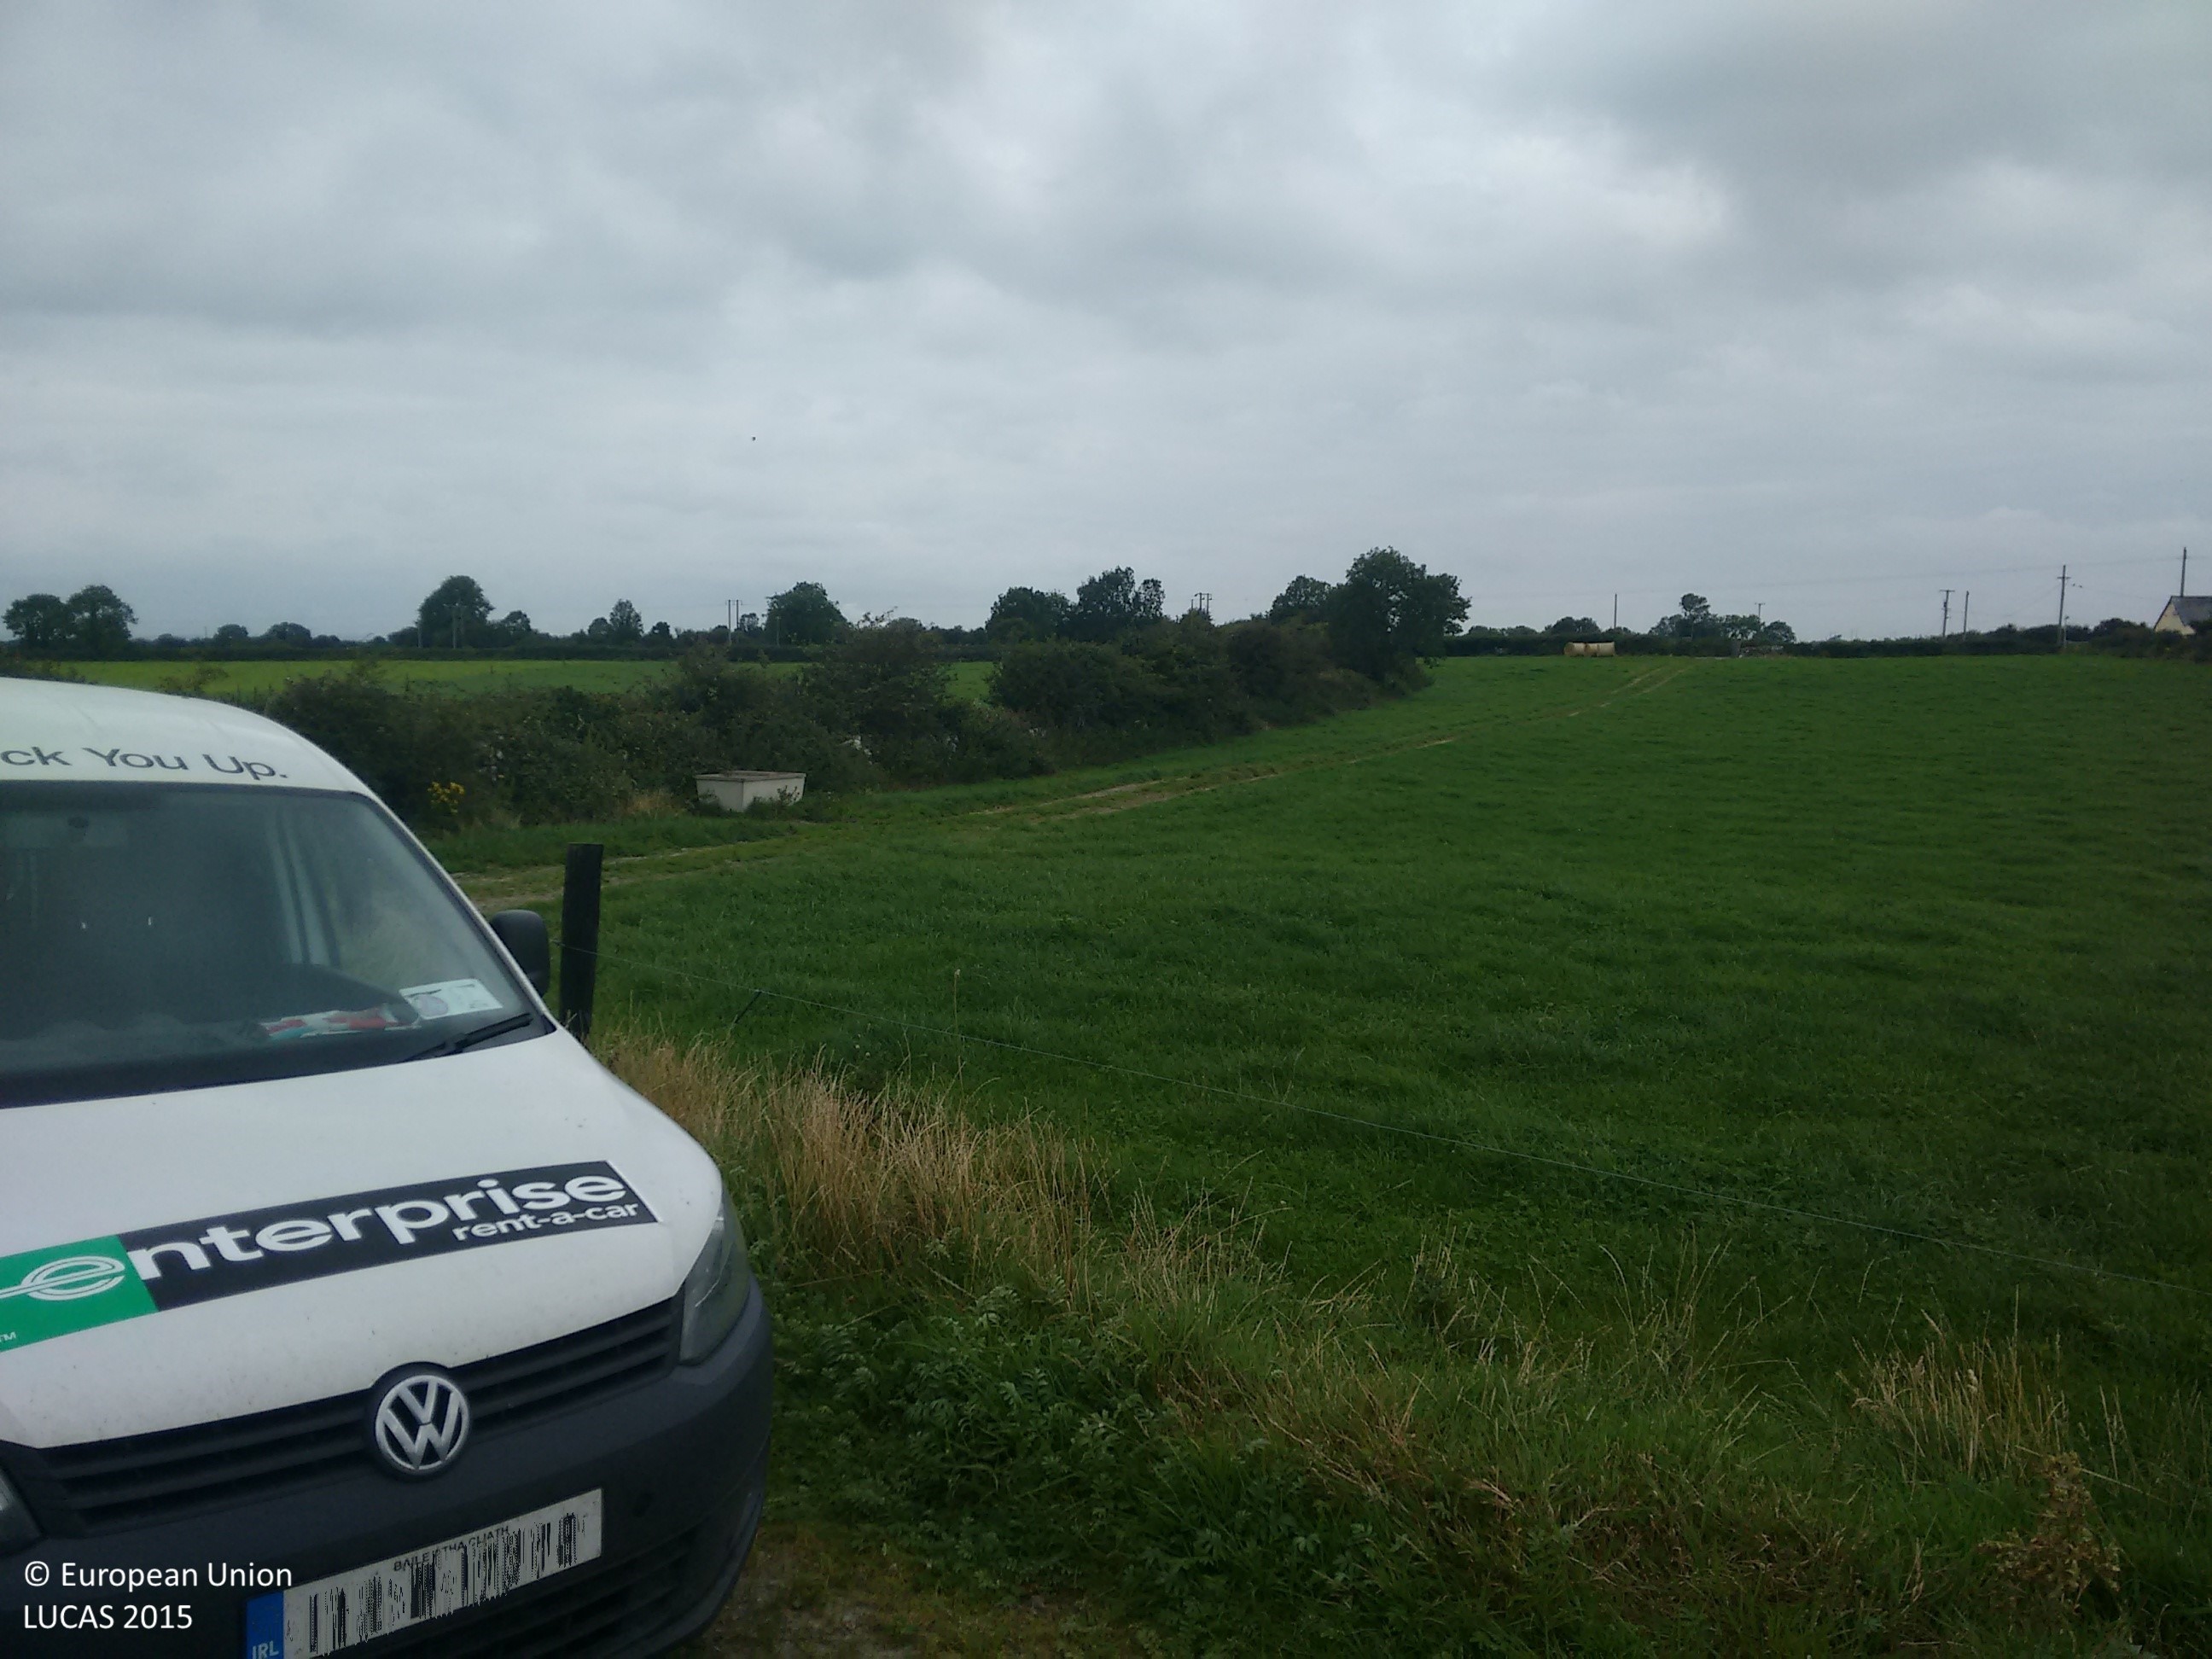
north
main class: Grassland
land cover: Grassland with sparse tree/shrub cover
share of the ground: > 75 %
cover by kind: herbaceous plants 95 %, broadleaved forest trees 5 %
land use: Agriculture (excluding fallow land and kitchen gardens)
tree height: > 5 m
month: September
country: IE
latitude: 52.5703
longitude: -9.0566
